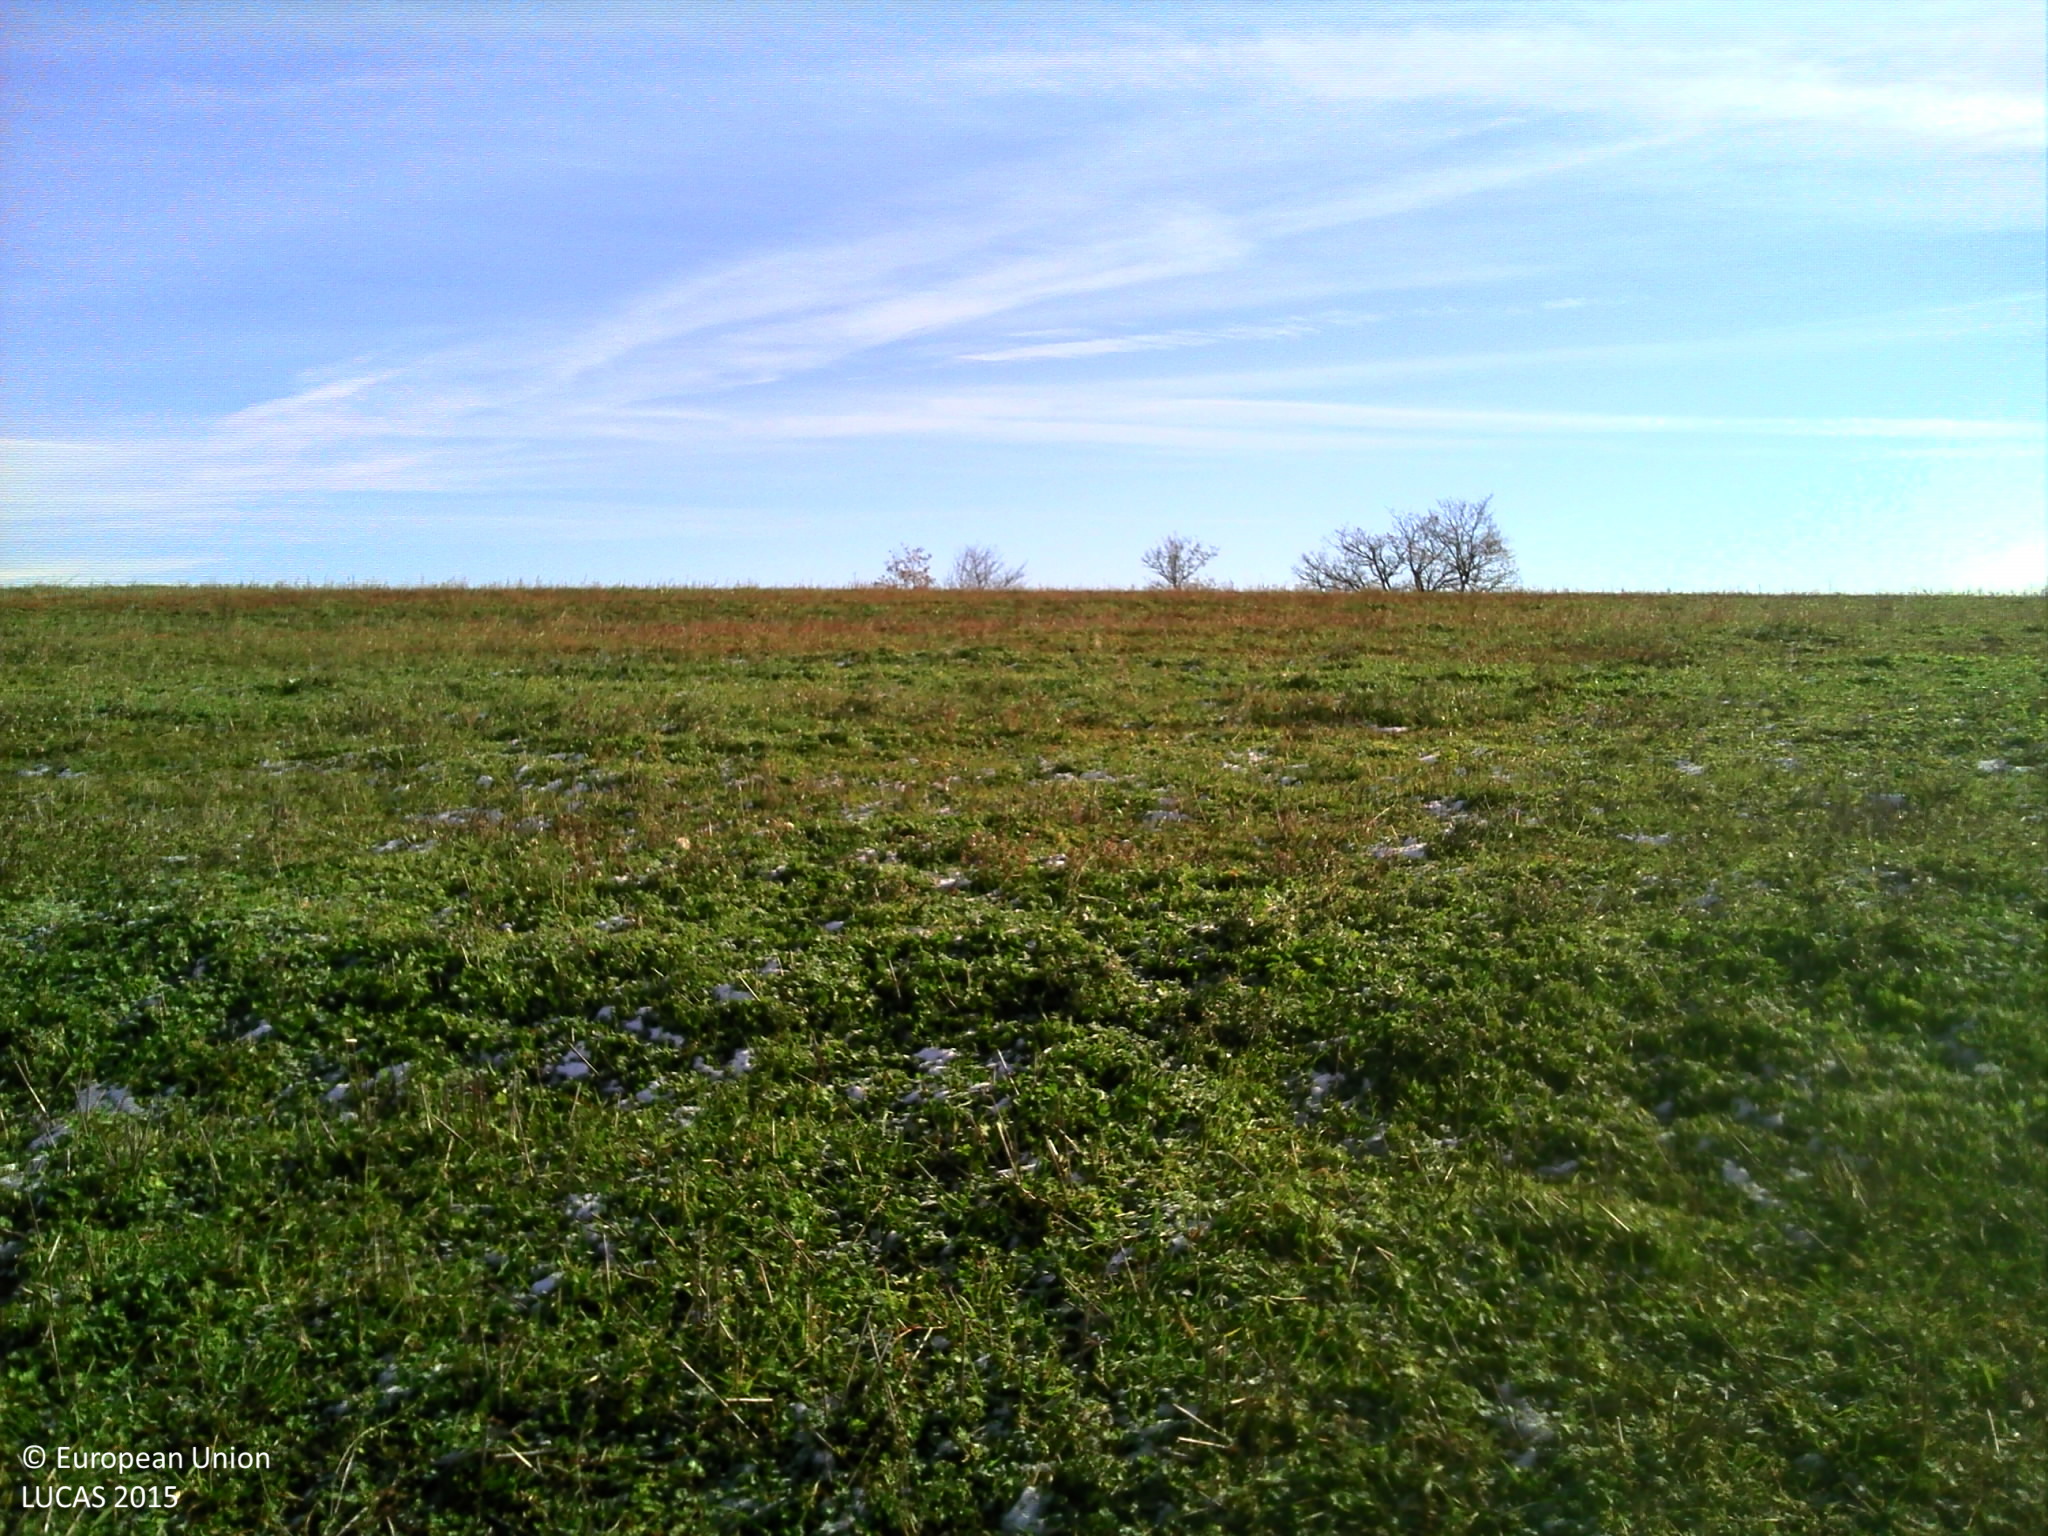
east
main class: Cropland
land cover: Temporary grasslands
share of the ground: > 75 %
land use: Agriculture (excluding fallow land and kitchen gardens)
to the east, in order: Temporary grasslands; Tracks; Abandoned hedges; Fences; Lucerne; Single bushes/trees; Grassland without tree/shrub cover; Broadleaved woodland; Grassland without tree/shrub cover; Lucerne; Broadleaved woodland
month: November
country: FR
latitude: 44.2035
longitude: 2.9850
